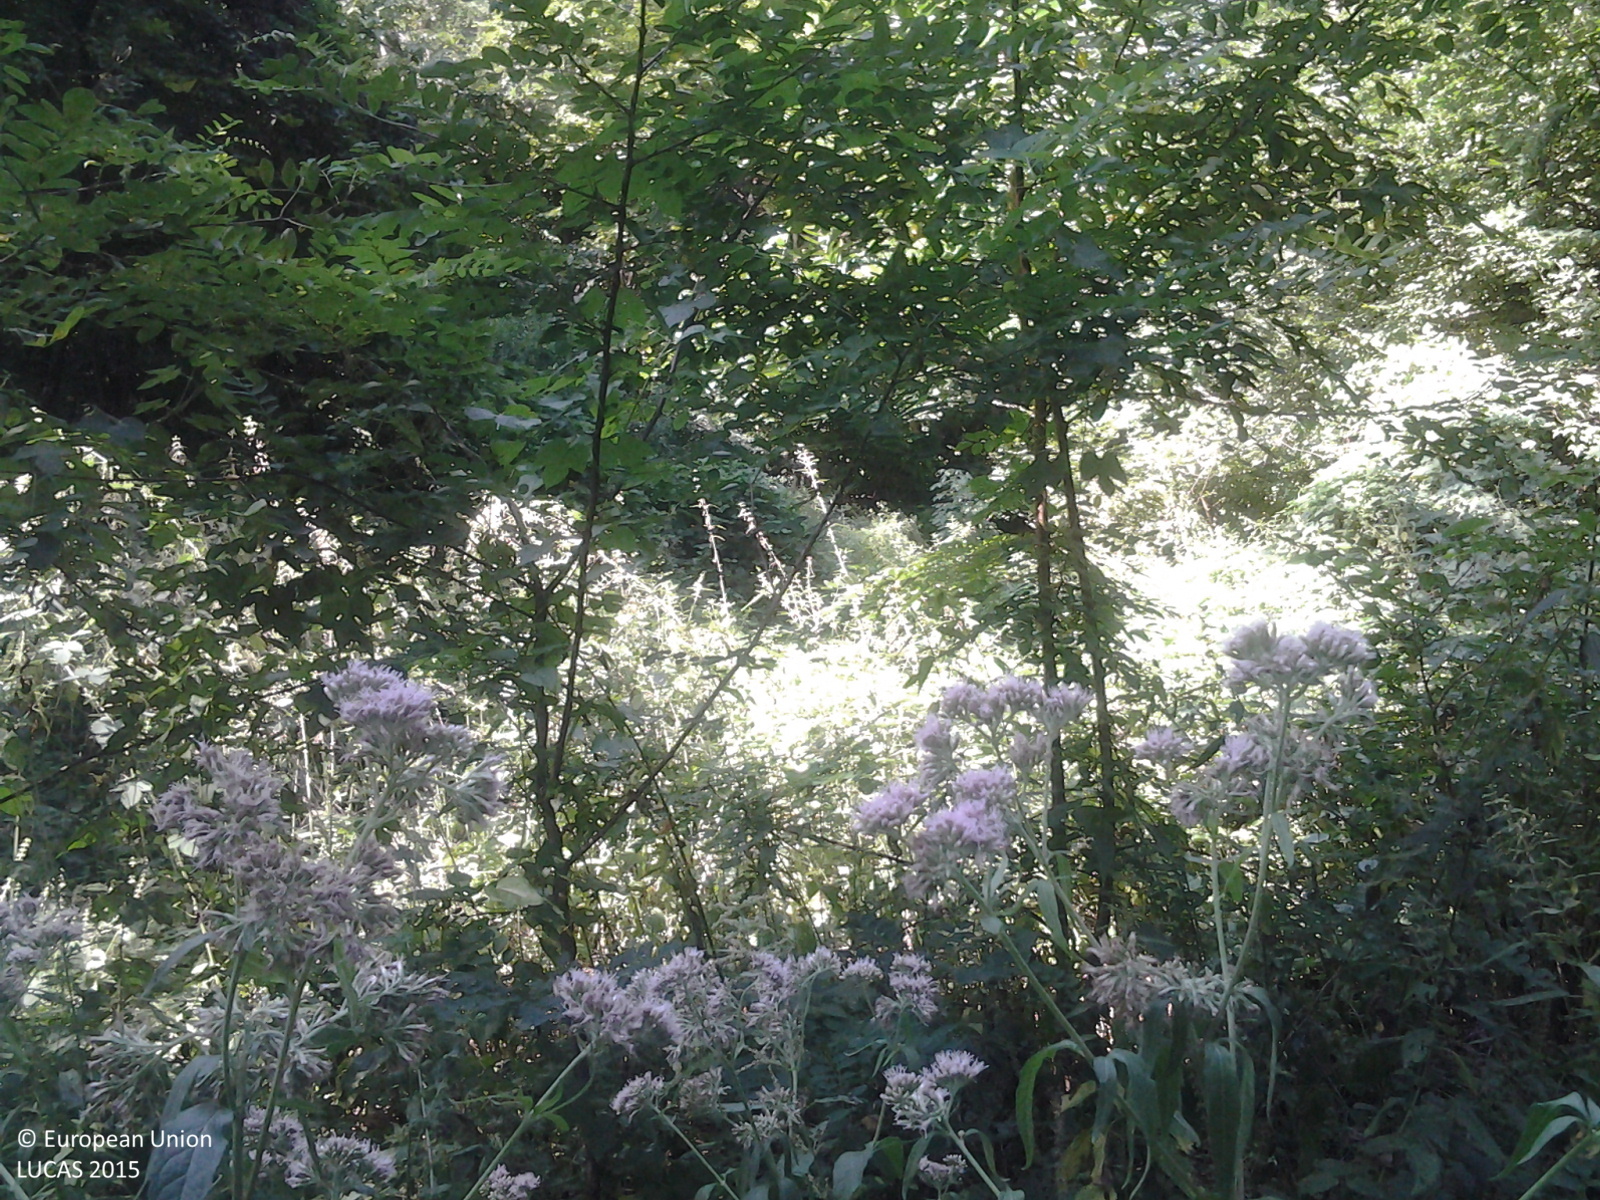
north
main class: Woodland
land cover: Broadleaved woodland
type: beech forest
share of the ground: > 75 %
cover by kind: broadleaved forest trees 90 %, herbaceous plants 10 %
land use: Forestry
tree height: > 5 m
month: August
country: HU
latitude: 46.5338
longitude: 17.0569
